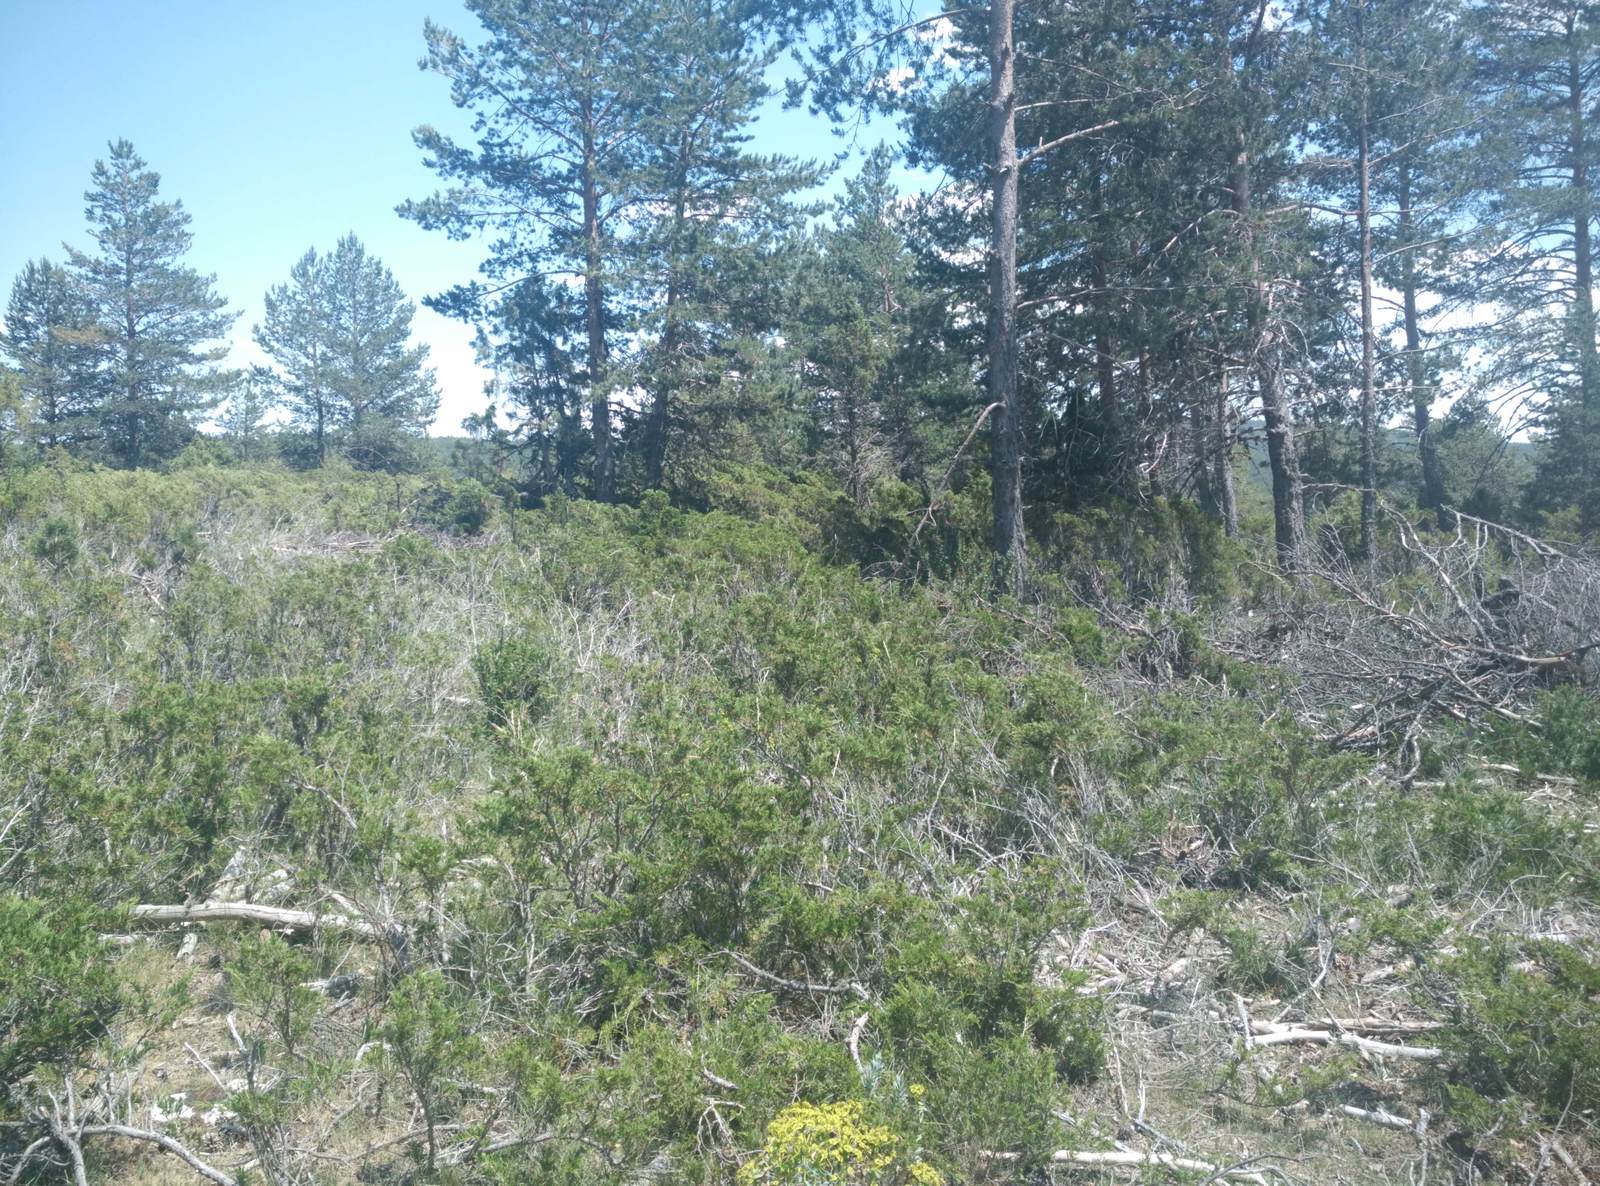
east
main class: Woodland
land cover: Pine dominated coniferous woodland
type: coniferous forest of the mediterranean region
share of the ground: 50 - 75 %
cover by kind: coniferous forest trees 50 %, shrubs 25 %, unconsolidated bare surface 25 %
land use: Semi-natural and natural areas not in use
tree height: > 5 m
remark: Clear cut
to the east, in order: Pine dominated coniferous woodland; Shrubland with sparse tree cover; Rock outcrops; Fences; Spontaneously vegetated surfaces; Fences; Pine dominated coniferous woodland; Tracks; Pine dominated coniferous woodland
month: June
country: ES
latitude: 40.5043
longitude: -1.7827
